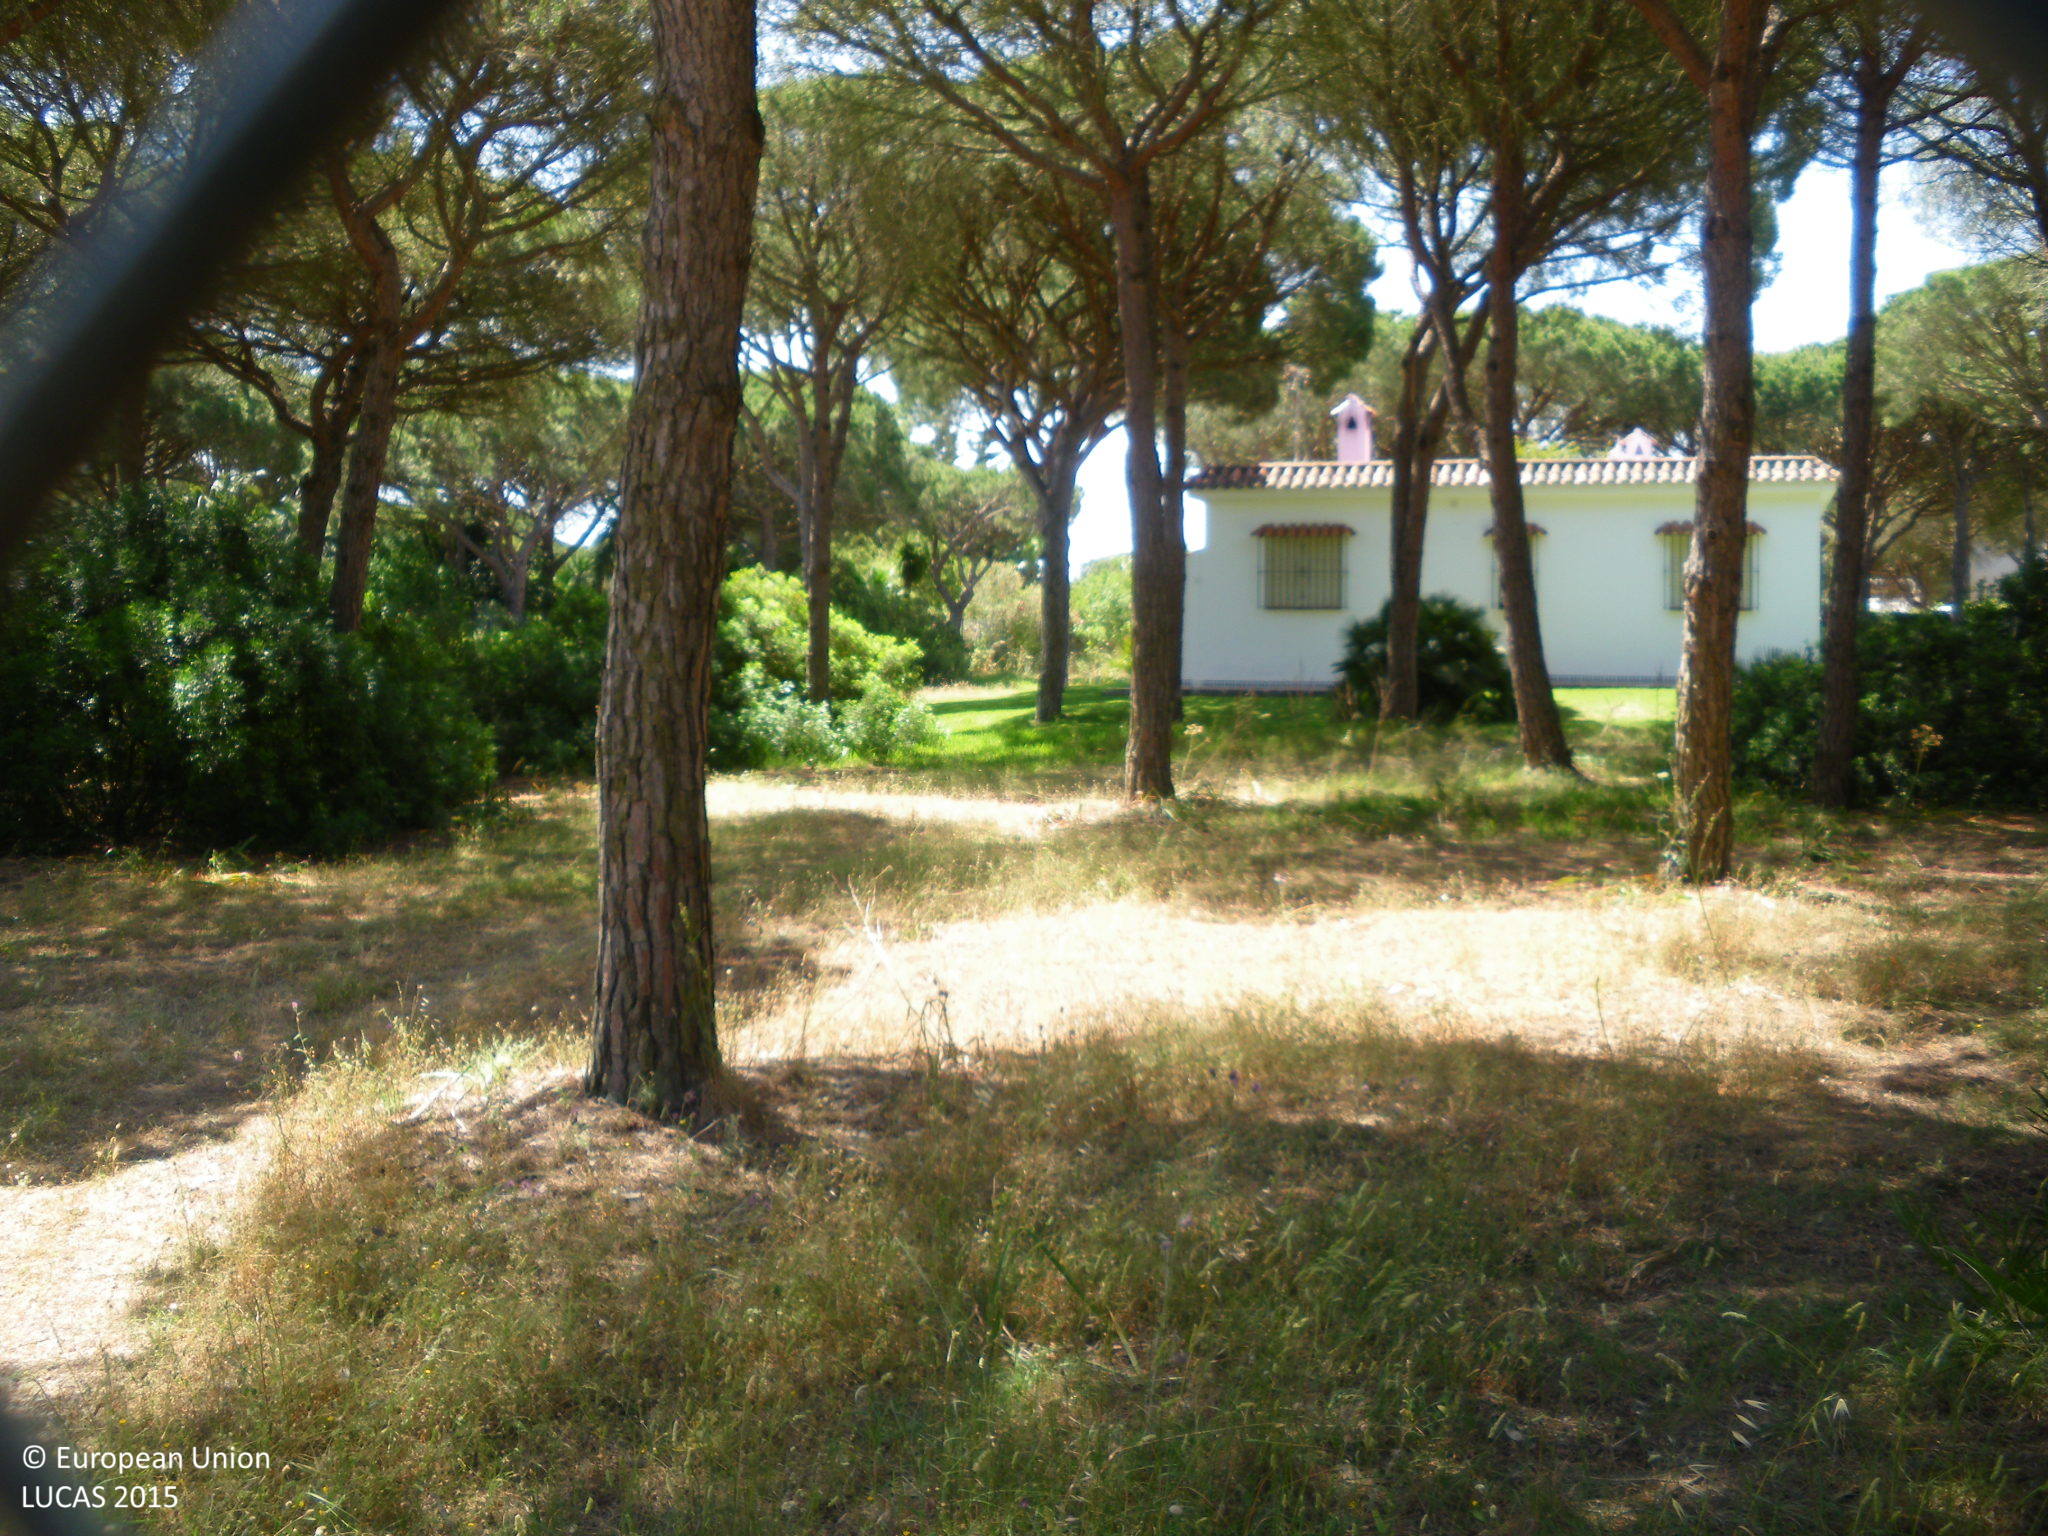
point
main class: Woodland
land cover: Pine dominated coniferous woodland
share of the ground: > 75 %
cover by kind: coniferous forest trees 90 %, shrubs 5 %, herbaceous plants 5 %
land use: Residential
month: May
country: ES
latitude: 36.3110
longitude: -6.0975
